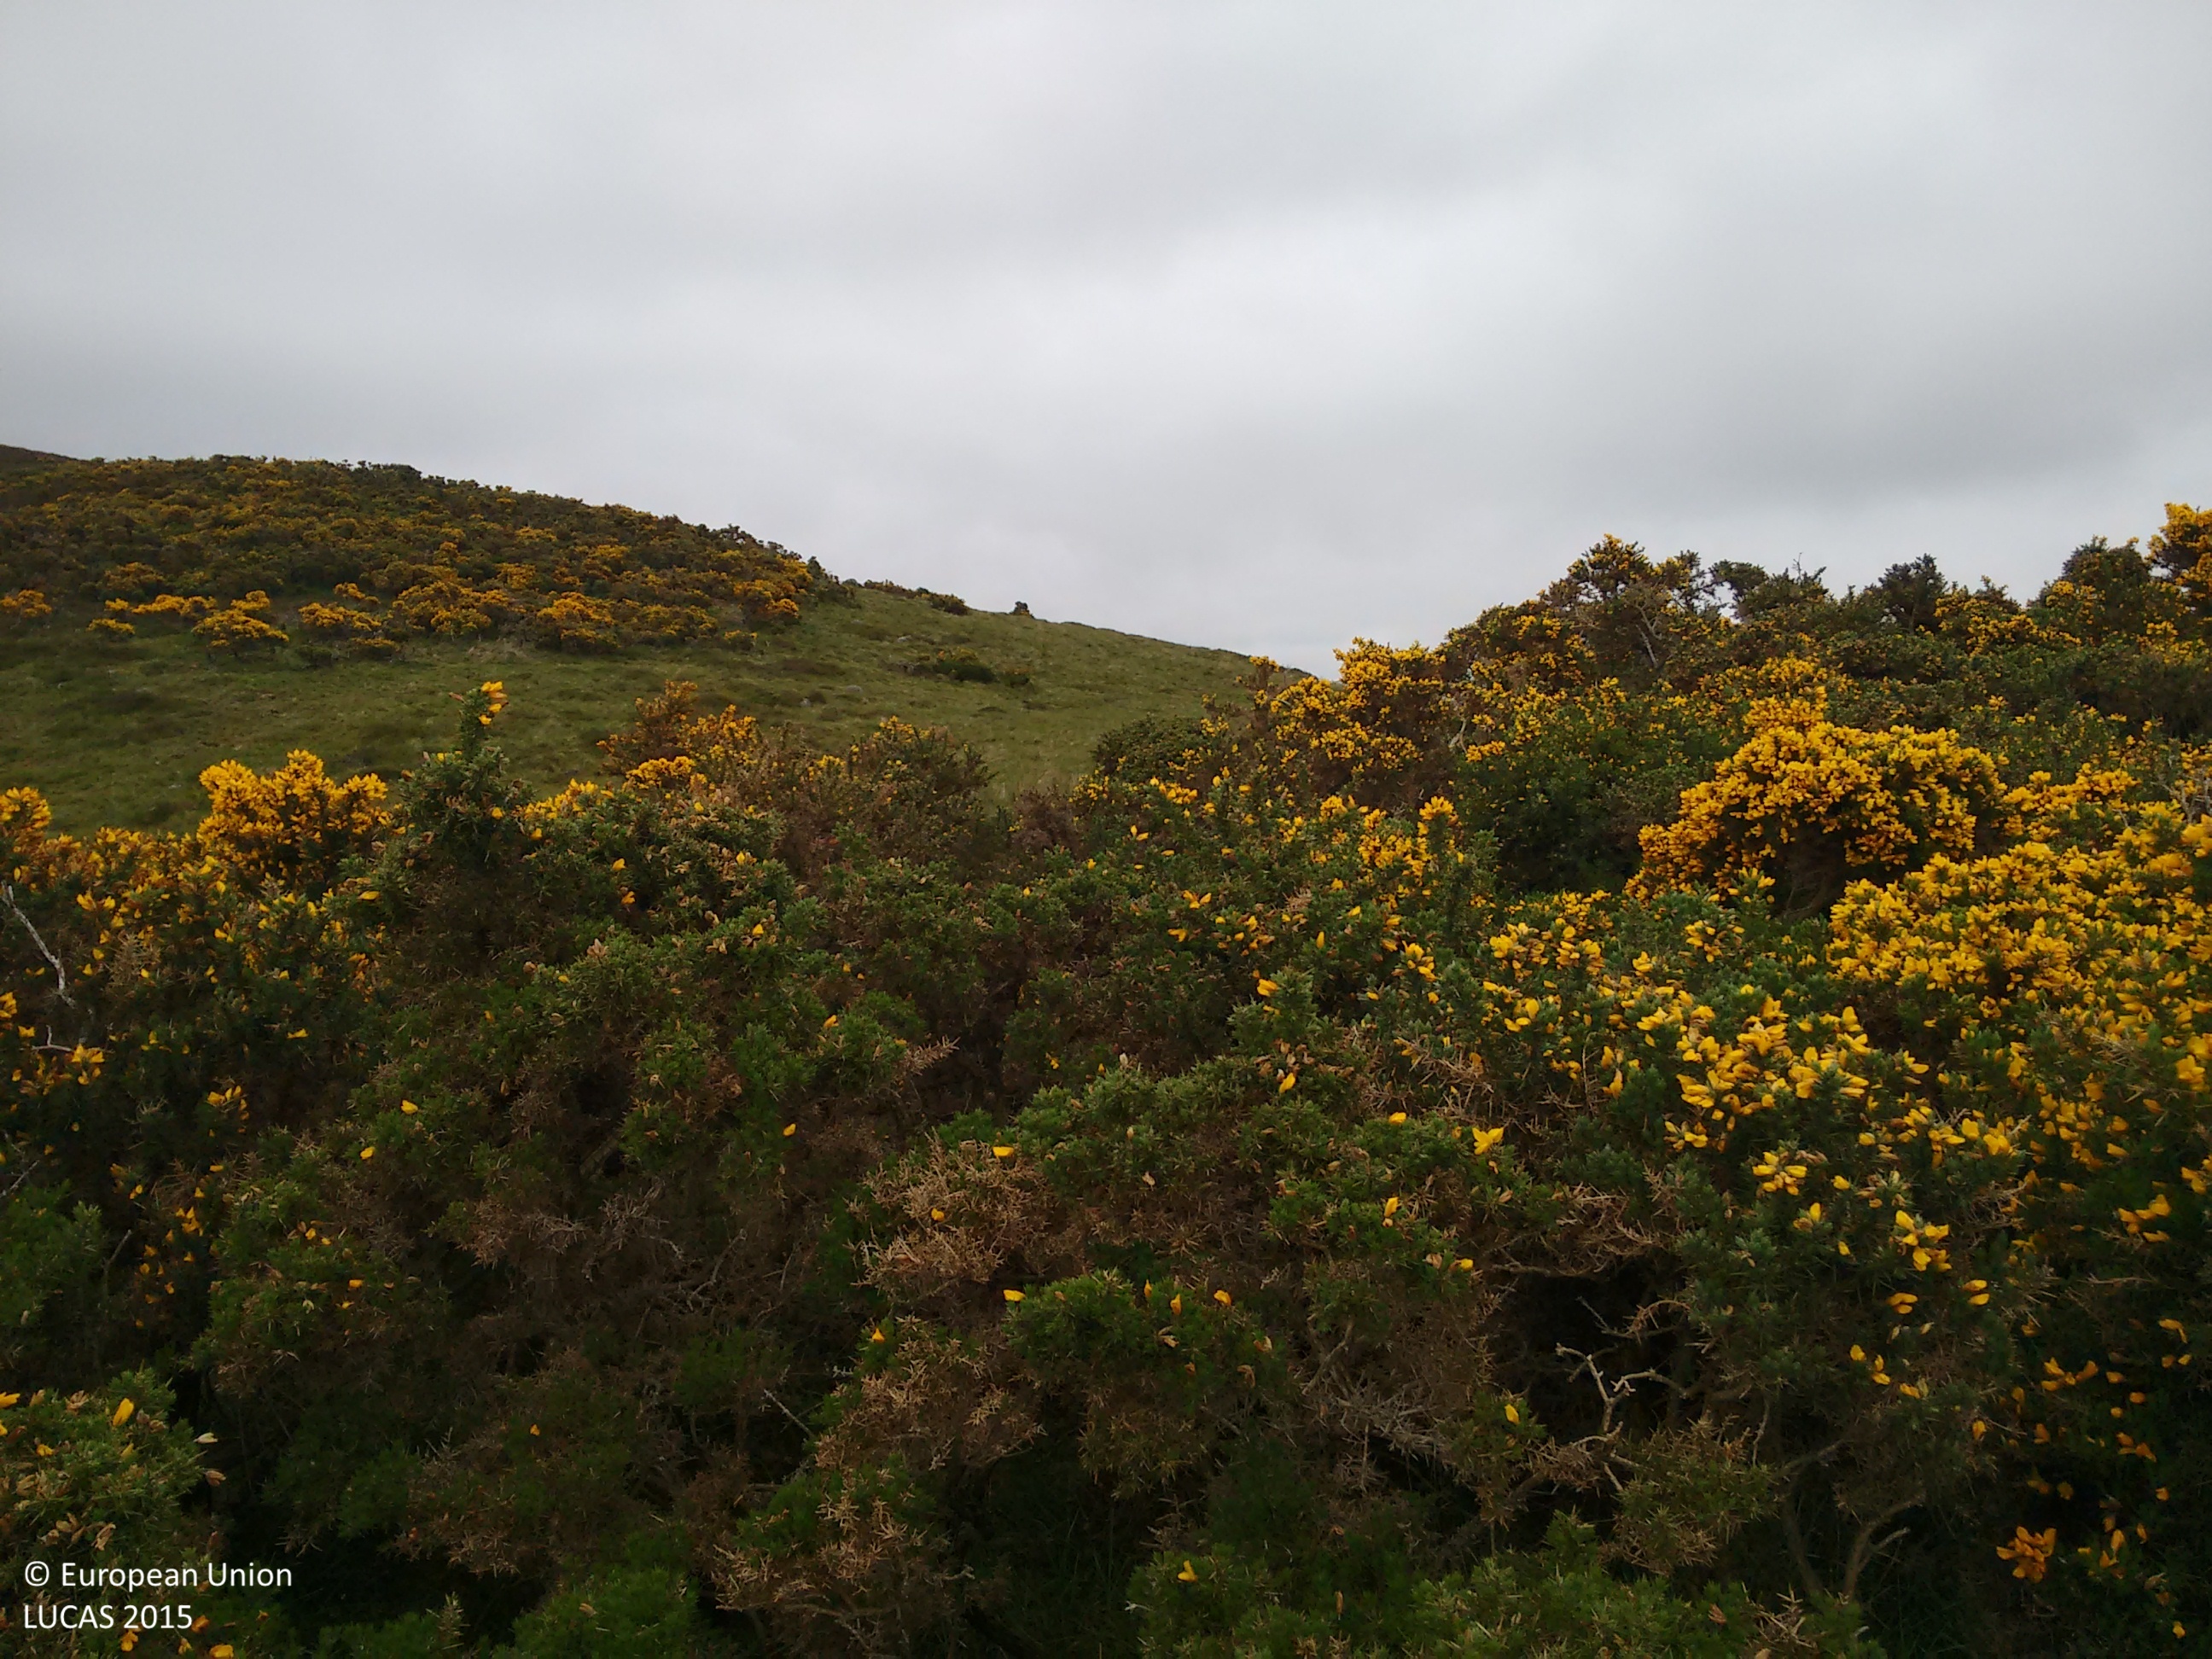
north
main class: Shrubland
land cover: Shrubland without tree cover
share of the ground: > 75 %
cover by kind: shrubs 90 %, herbaceous plants 5 %, lichens and mosses 5 %
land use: Semi-natural and natural areas not in use
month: June
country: GB
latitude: 57.0370
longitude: -2.6306
